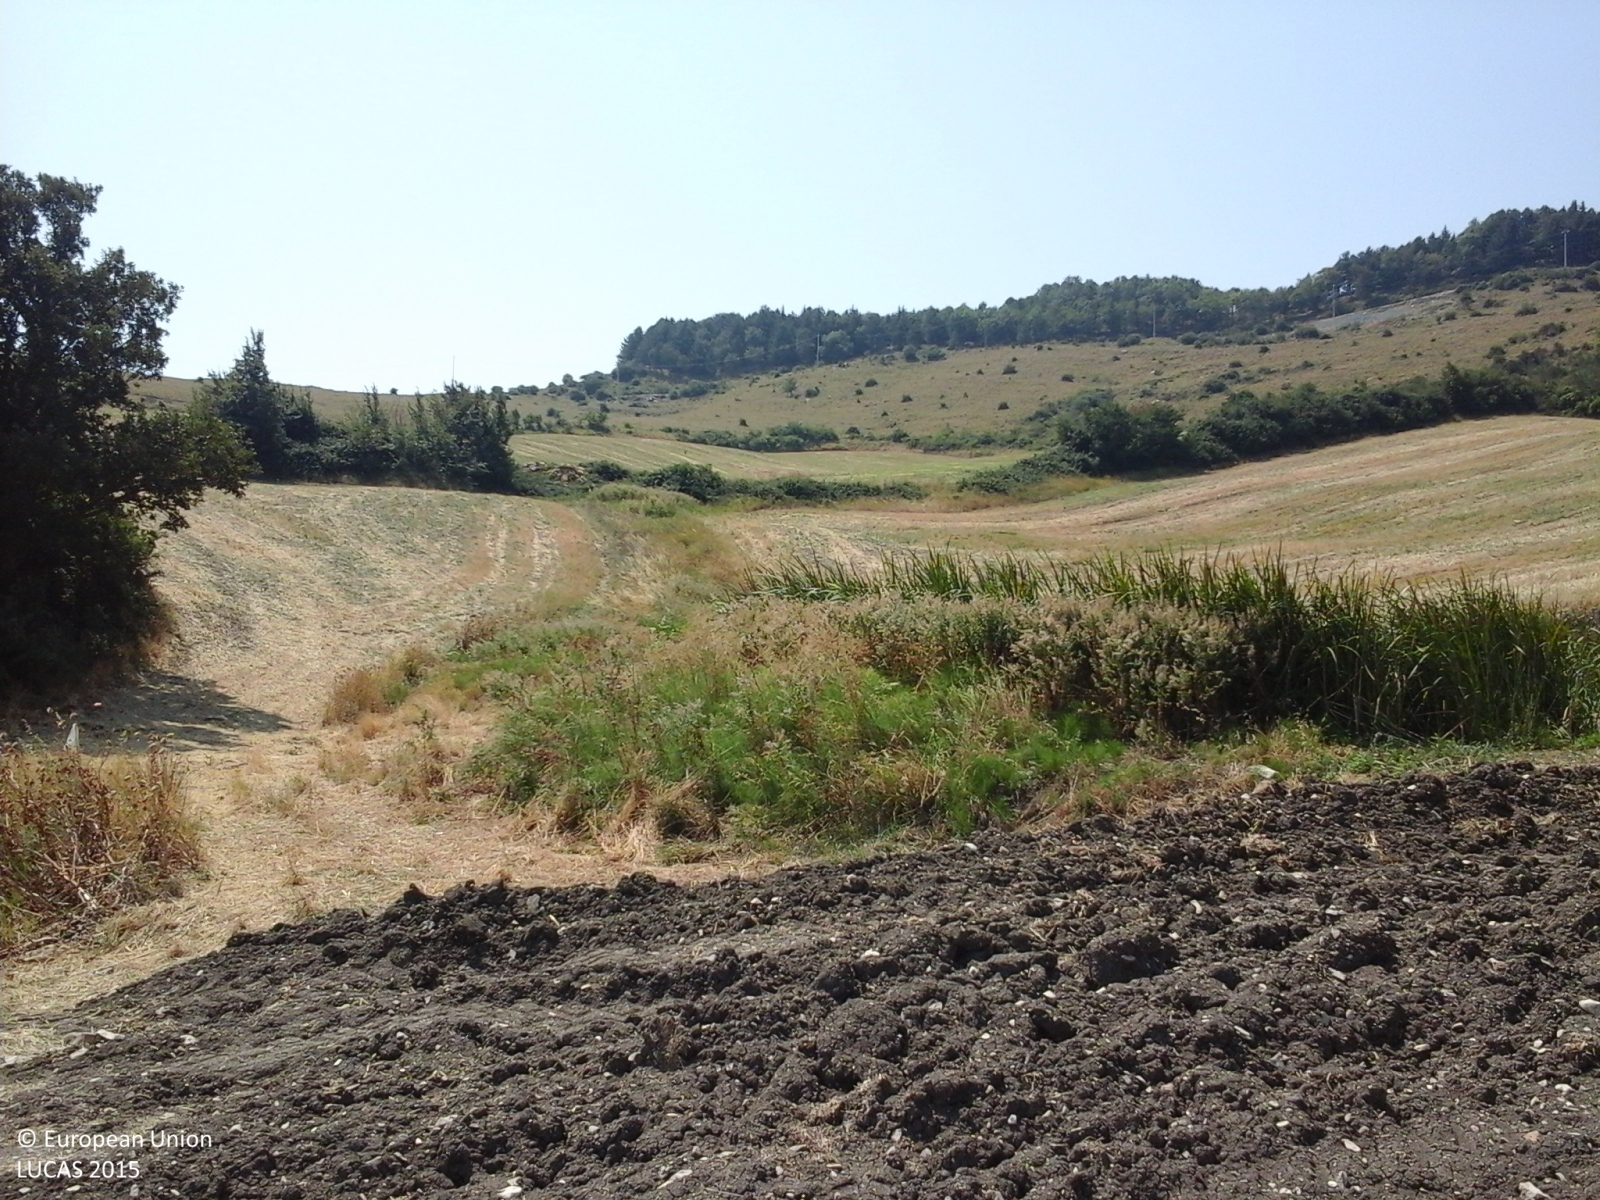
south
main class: Shrubland
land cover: Shrubland with sparse tree cover
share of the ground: > 75 %
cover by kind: shrubs 95 %, broadleaved forest trees 5 %
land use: Abandoned areas
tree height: > 5 m
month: August
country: IT
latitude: 41.3627
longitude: 15.1821
